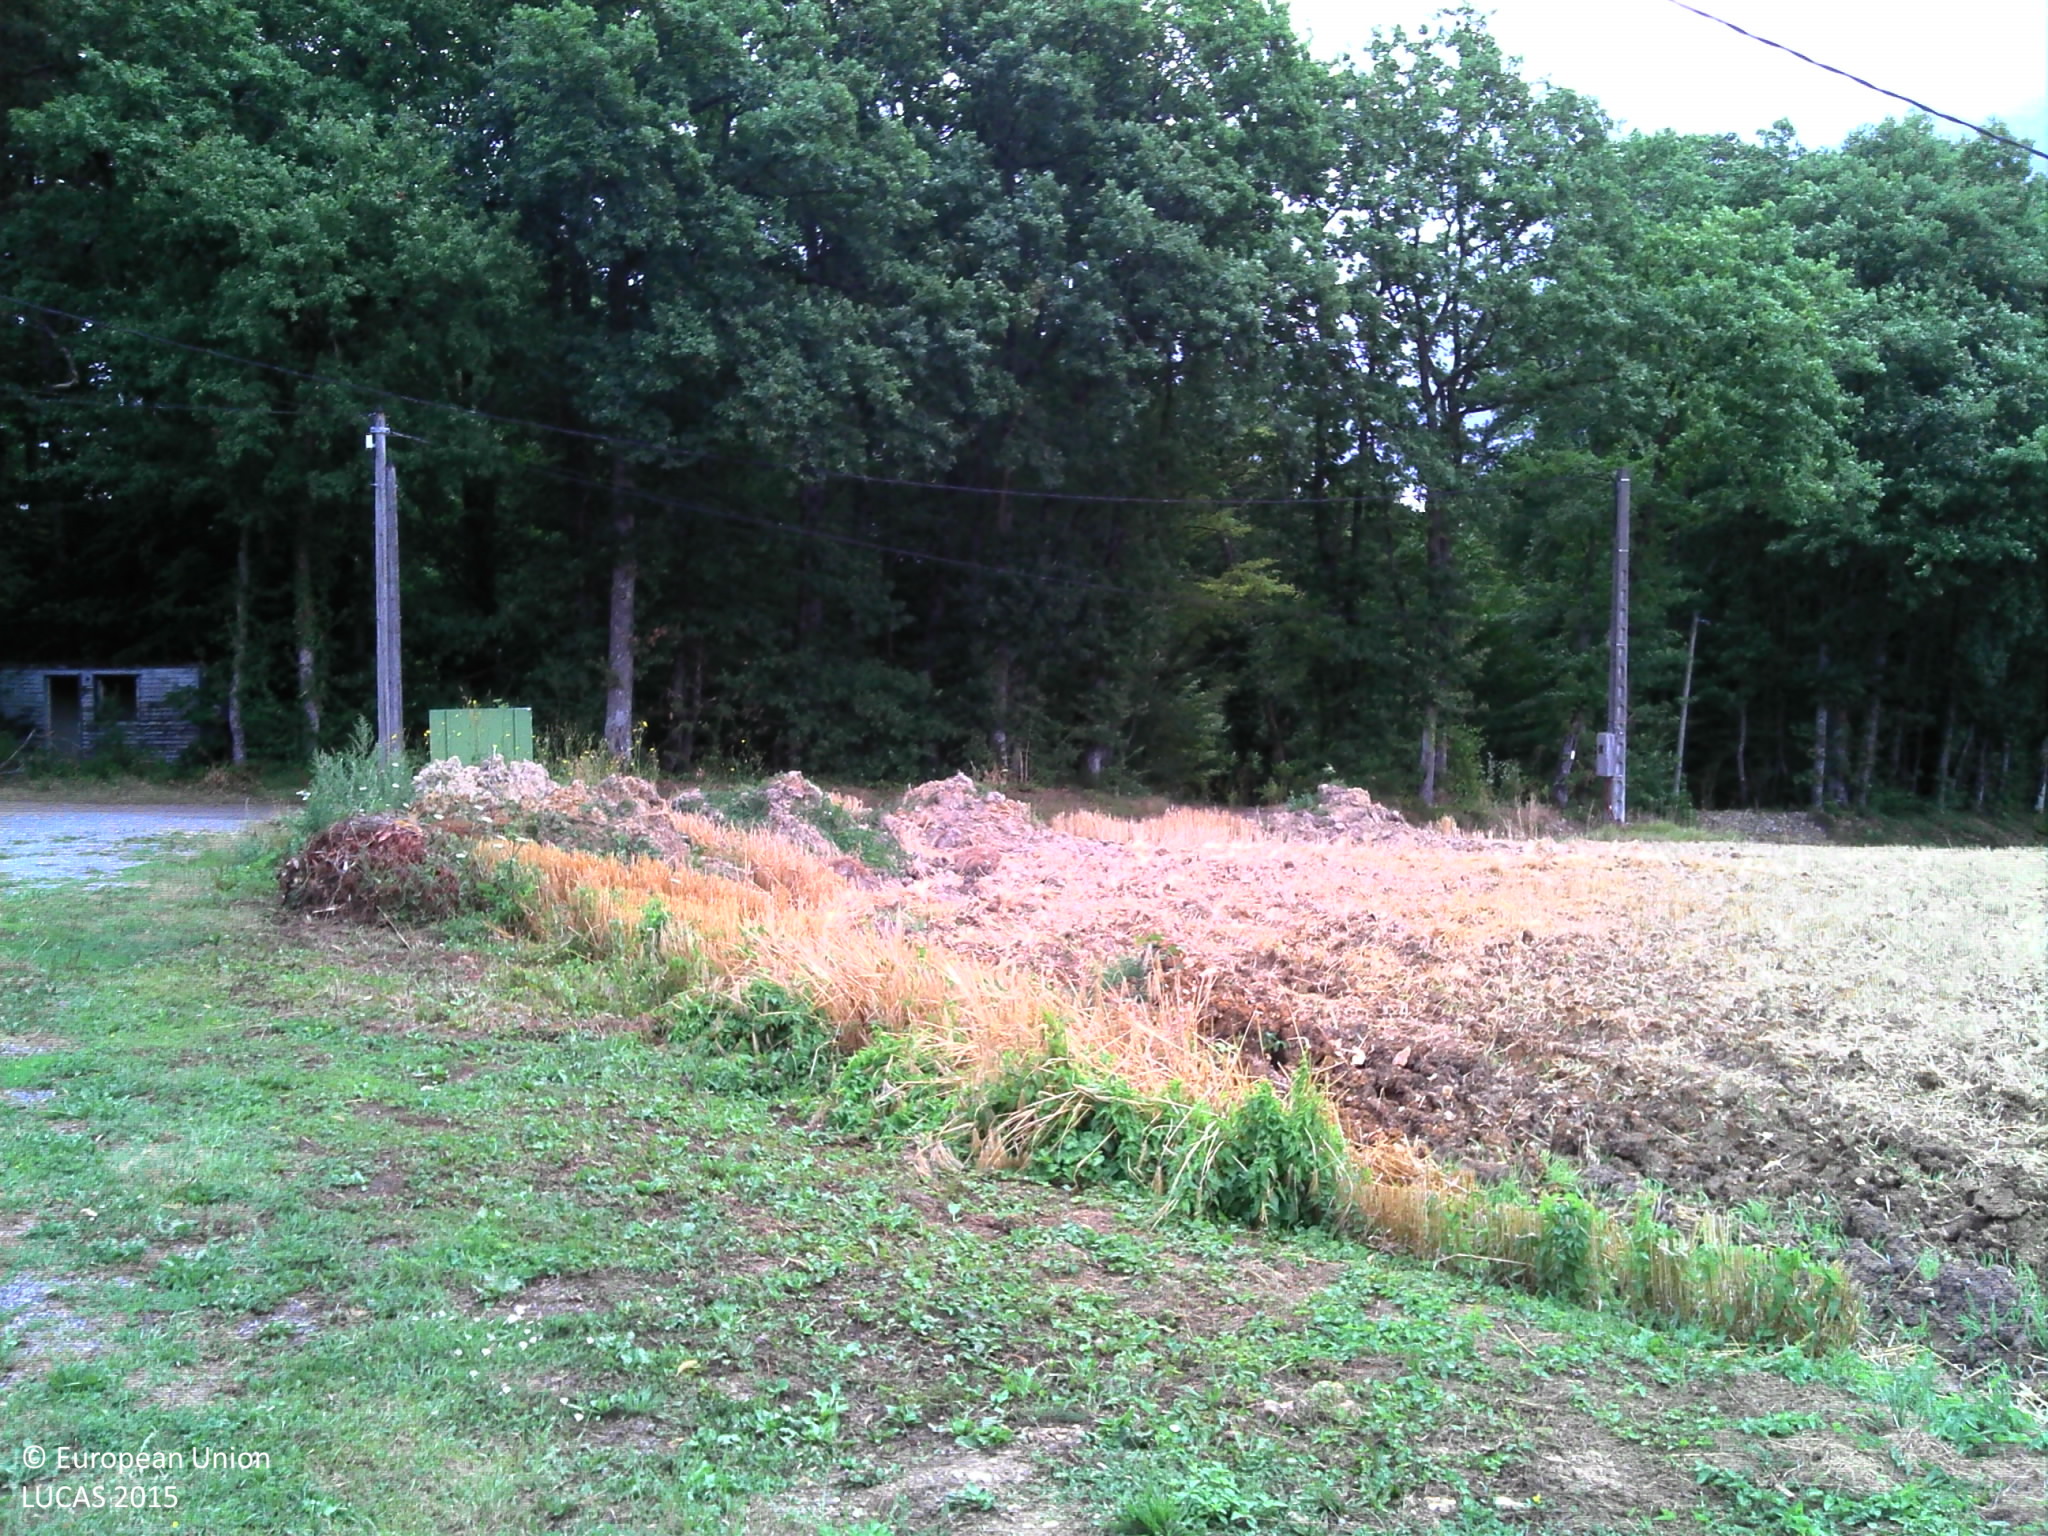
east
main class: Grassland
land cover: Grassland with sparse tree/shrub cover
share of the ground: > 75 %
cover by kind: herbaceous plants 90 %, broadleaved forest trees 5 %, shrubs 5 %
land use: Amenities, museums, leisure
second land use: Residential
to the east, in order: Grassland with sparse tree/shrub cover; Artificial constructions in urban areas; Grassland without tree/shrub cover; Barley; Electric lines; Grass margins; Paved roads, cycling and walking lanes; Grass margins; Broadleaved woodland; Artificial constructions in urban areas; Broadleaved woodland; Other bare soil; Electric lines; Grass margins; Paved roads, cycling and walking lanes; Grass margins; Other structural elements; Spruce dominated coniferous woodland
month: July
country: FR
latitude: 48.0801
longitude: 3.4036
